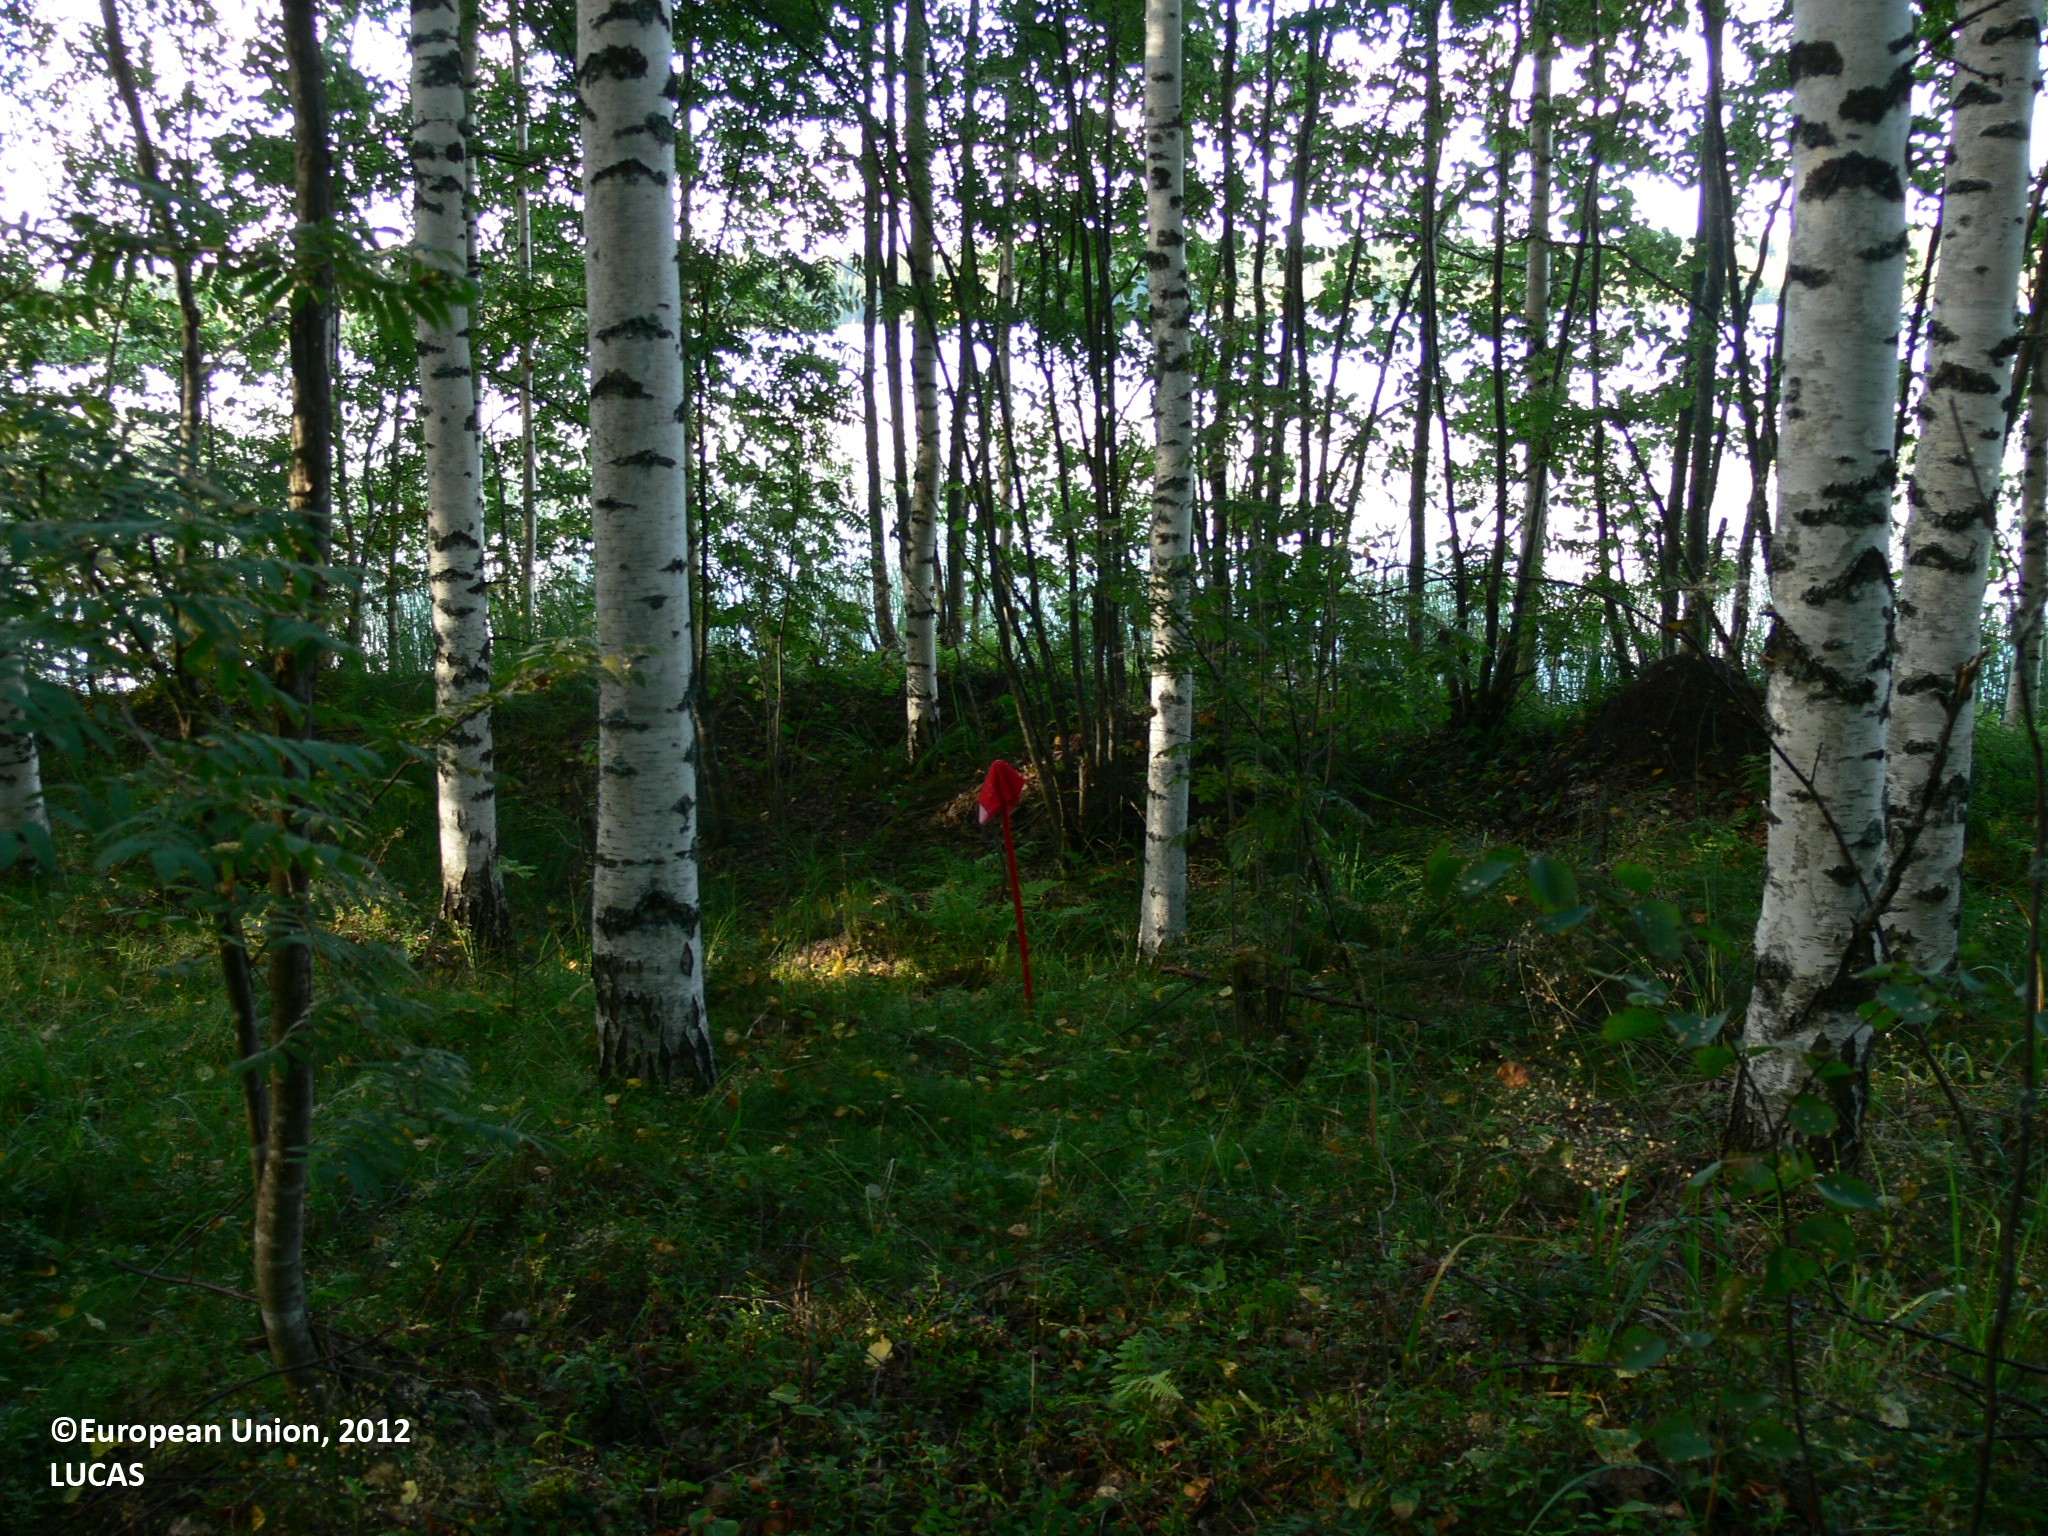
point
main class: Woodland
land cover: Broadleaved woodland
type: boreal forest
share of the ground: > 75 %
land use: Forestry
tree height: > 5 m
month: August
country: FI
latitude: 61.9926
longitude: 29.1884
